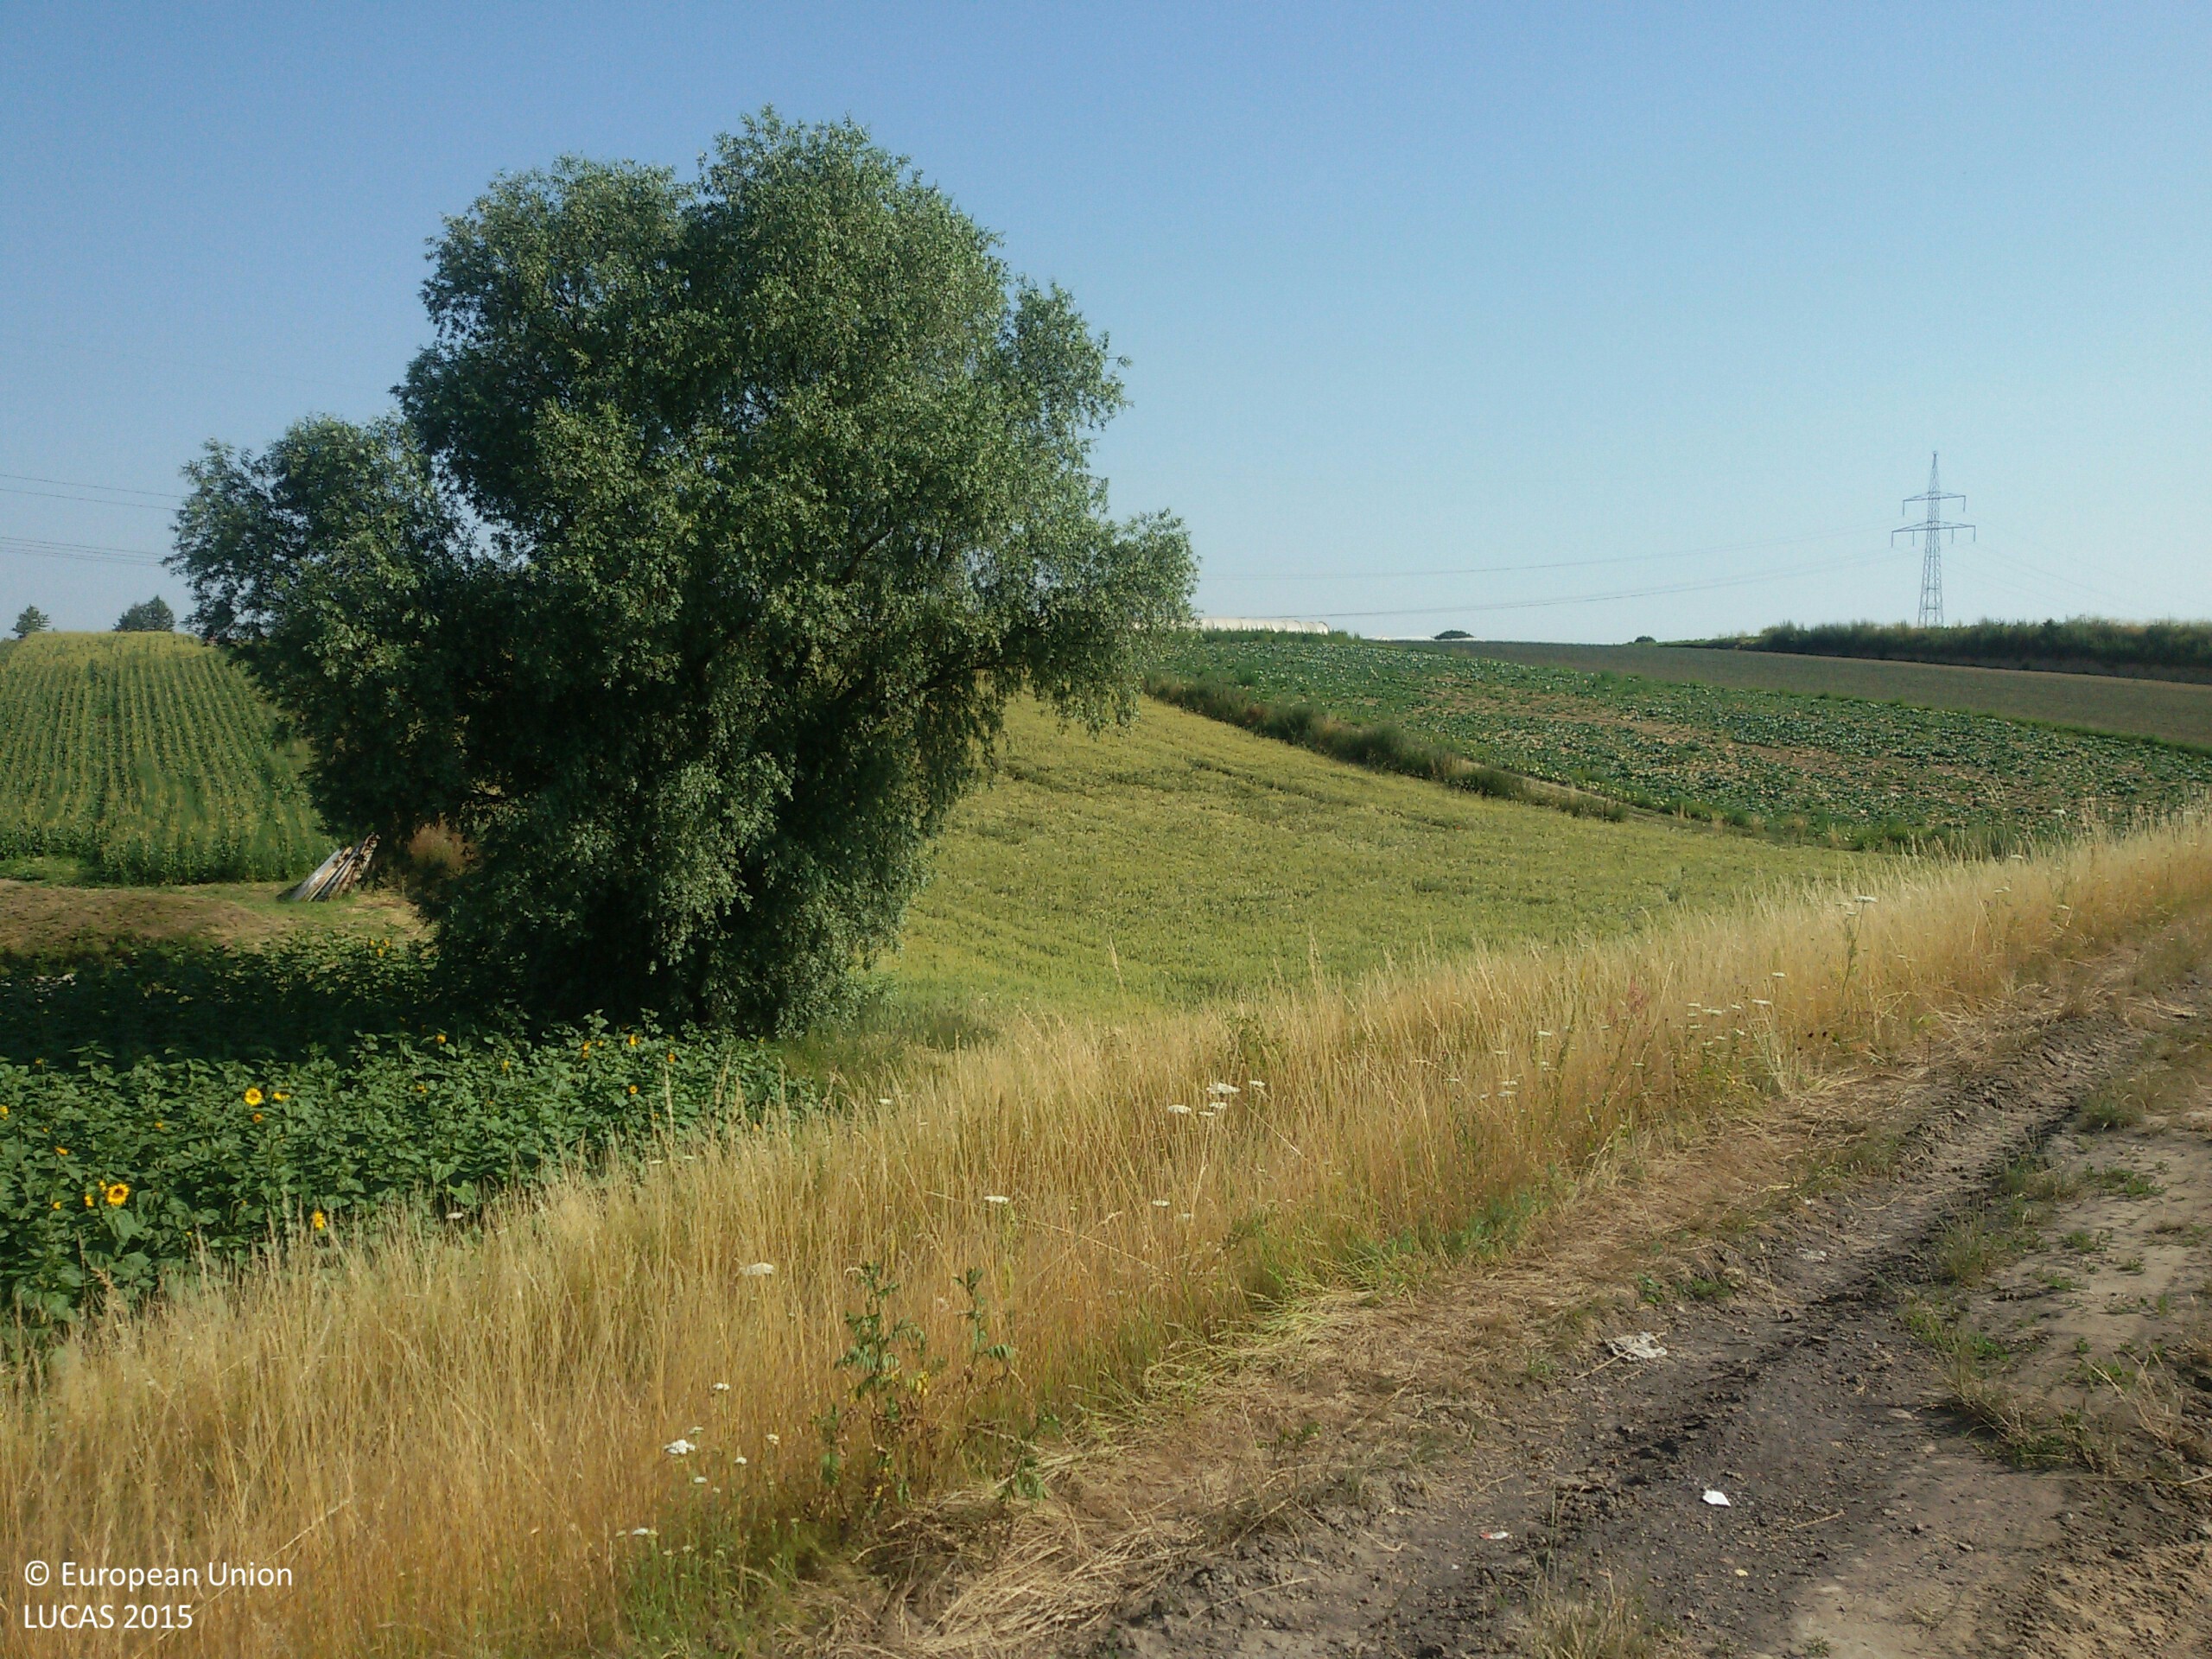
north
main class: Grassland
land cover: Spontaneously vegetated surfaces
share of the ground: > 75 %
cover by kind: herbaceous plants 100 %
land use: Semi-natural and natural areas not in use
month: July
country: PL
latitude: 50.1116
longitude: 20.3418
